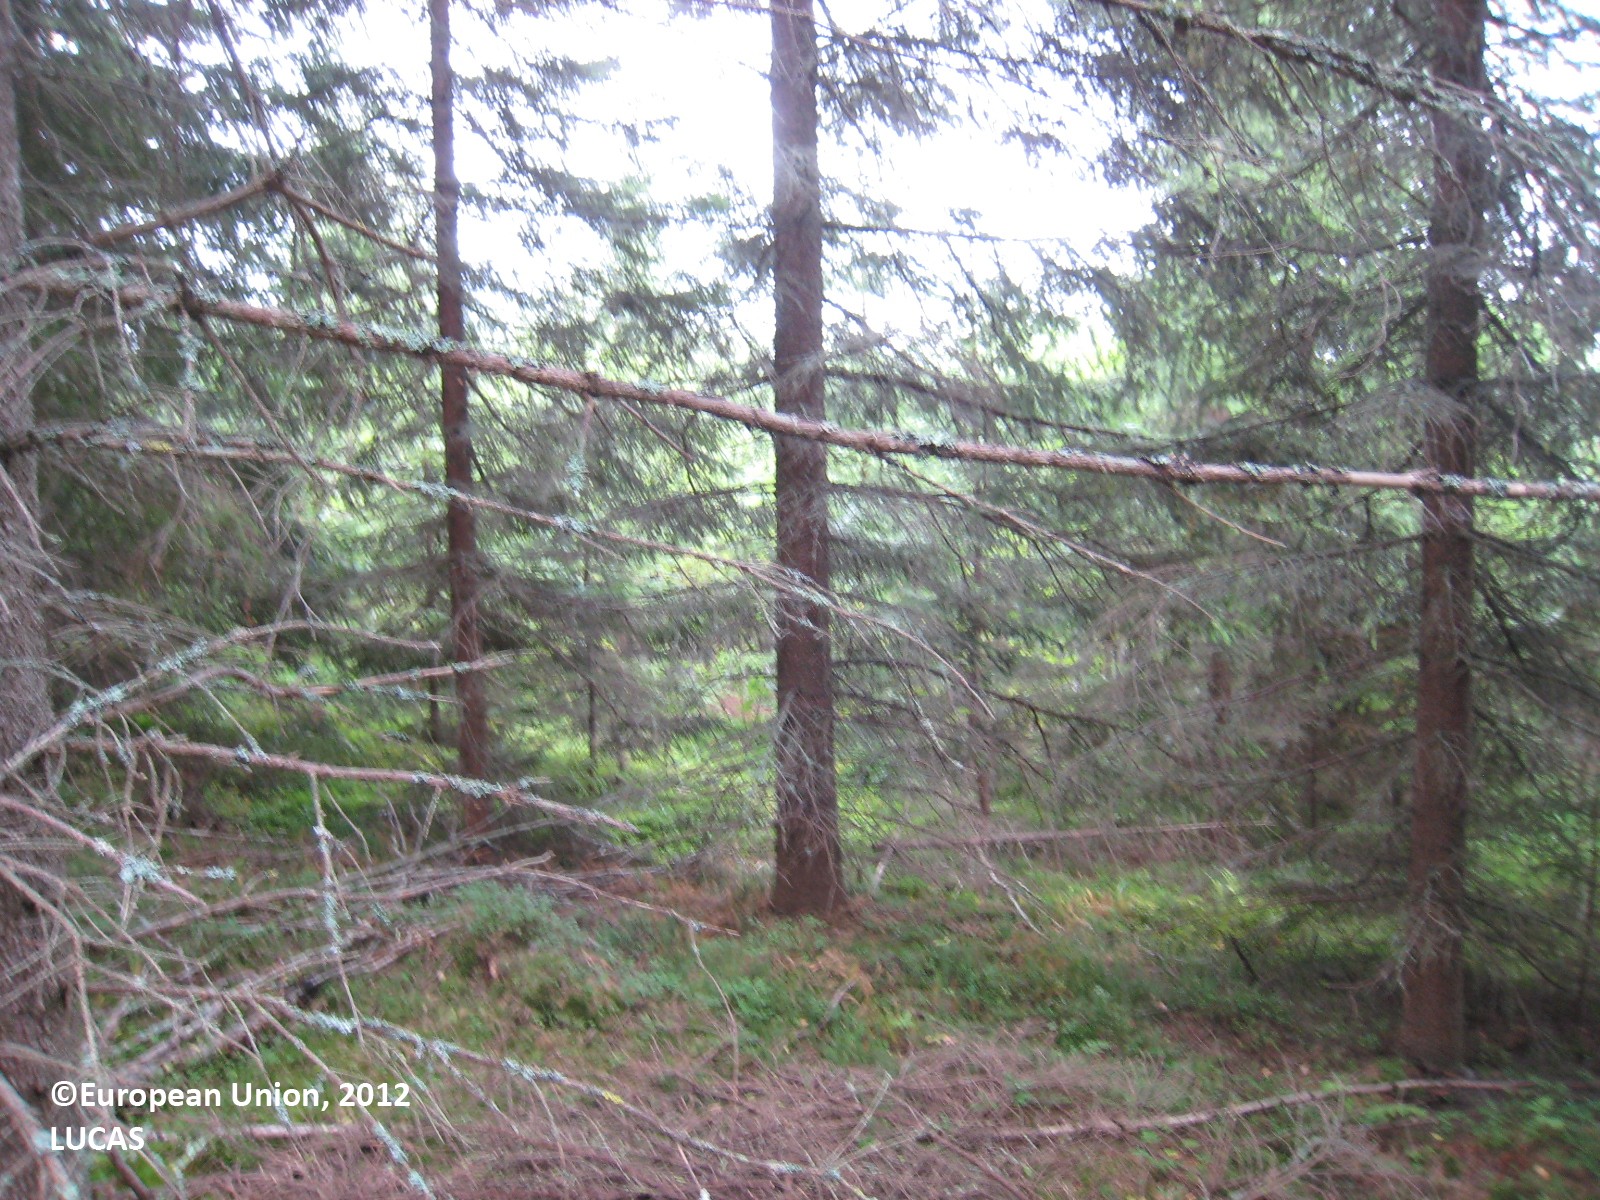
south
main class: Woodland
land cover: Spruce dominated coniferous woodland
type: boreal forest
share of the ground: 50 - 75 %
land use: Forestry
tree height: > 5 m
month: August
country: FI
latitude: 61.8292
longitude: 26.1020
